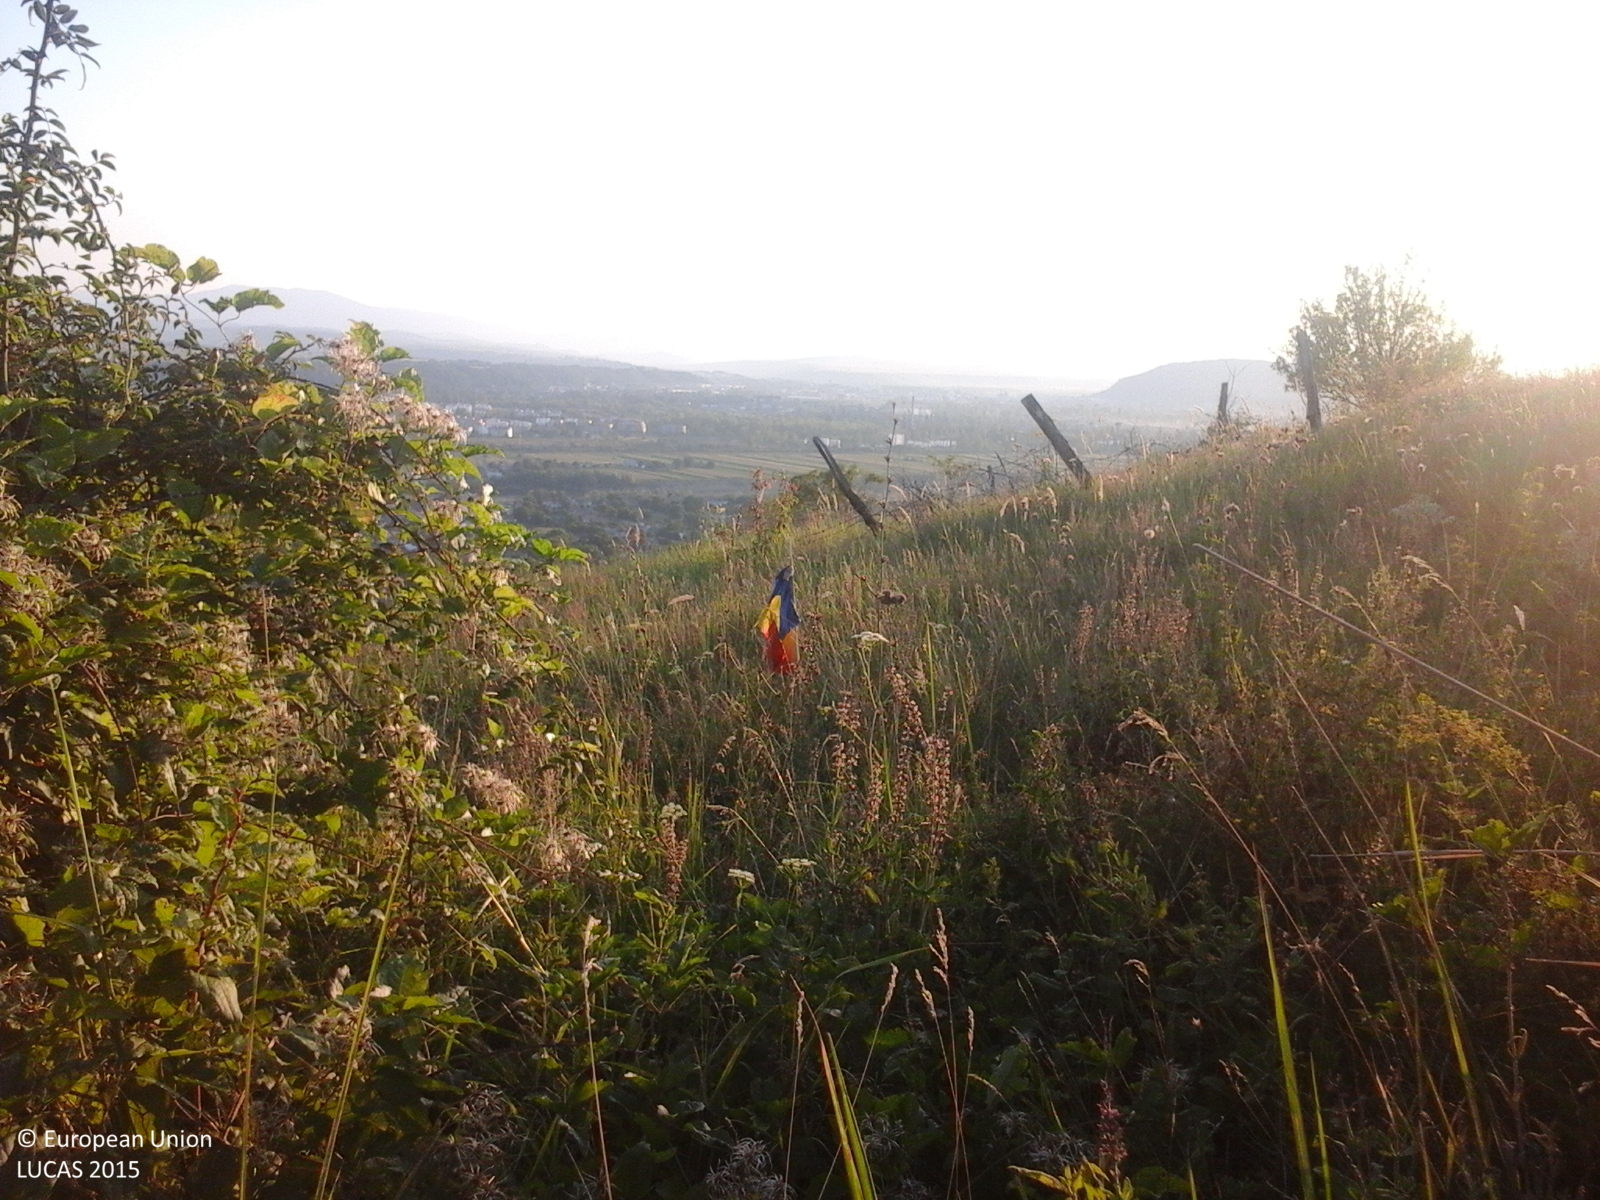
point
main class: Grassland
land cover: Grassland with sparse tree/shrub cover
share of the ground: > 75 %
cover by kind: herbaceous plants 85 %, shrubs 10 %, broadleaved forest trees 5 %
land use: Agriculture (excluding fallow land and kitchen gardens)
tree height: < 5 m
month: August
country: RO
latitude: 46.2719
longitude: 26.8419
